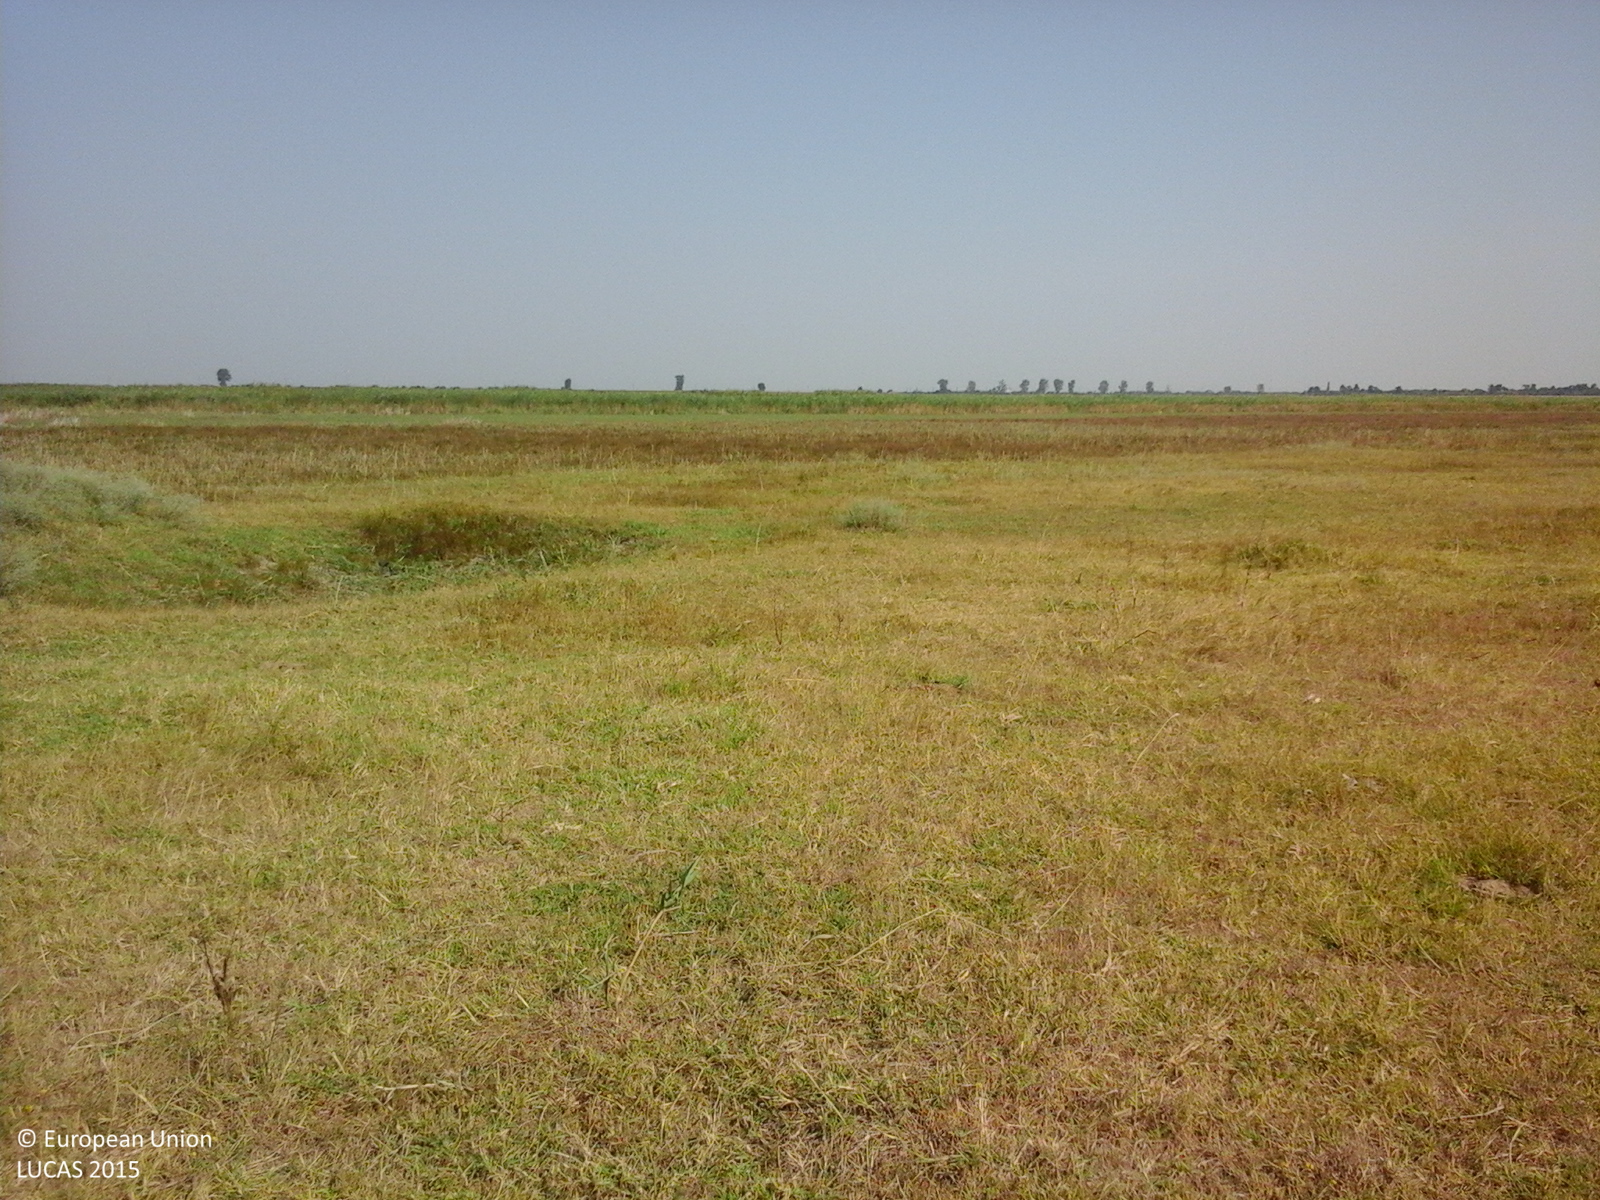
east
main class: Grassland
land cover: Grassland without tree/shrub cover
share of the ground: > 75 %
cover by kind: herbaceous plants 100 %
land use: Agriculture (excluding fallow land and kitchen gardens)
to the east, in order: Grassland without tree/shrub cover; Inland marshes; Inland fresh running water; Inland marshes
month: August
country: RO
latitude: 45.2074
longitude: 27.7142
